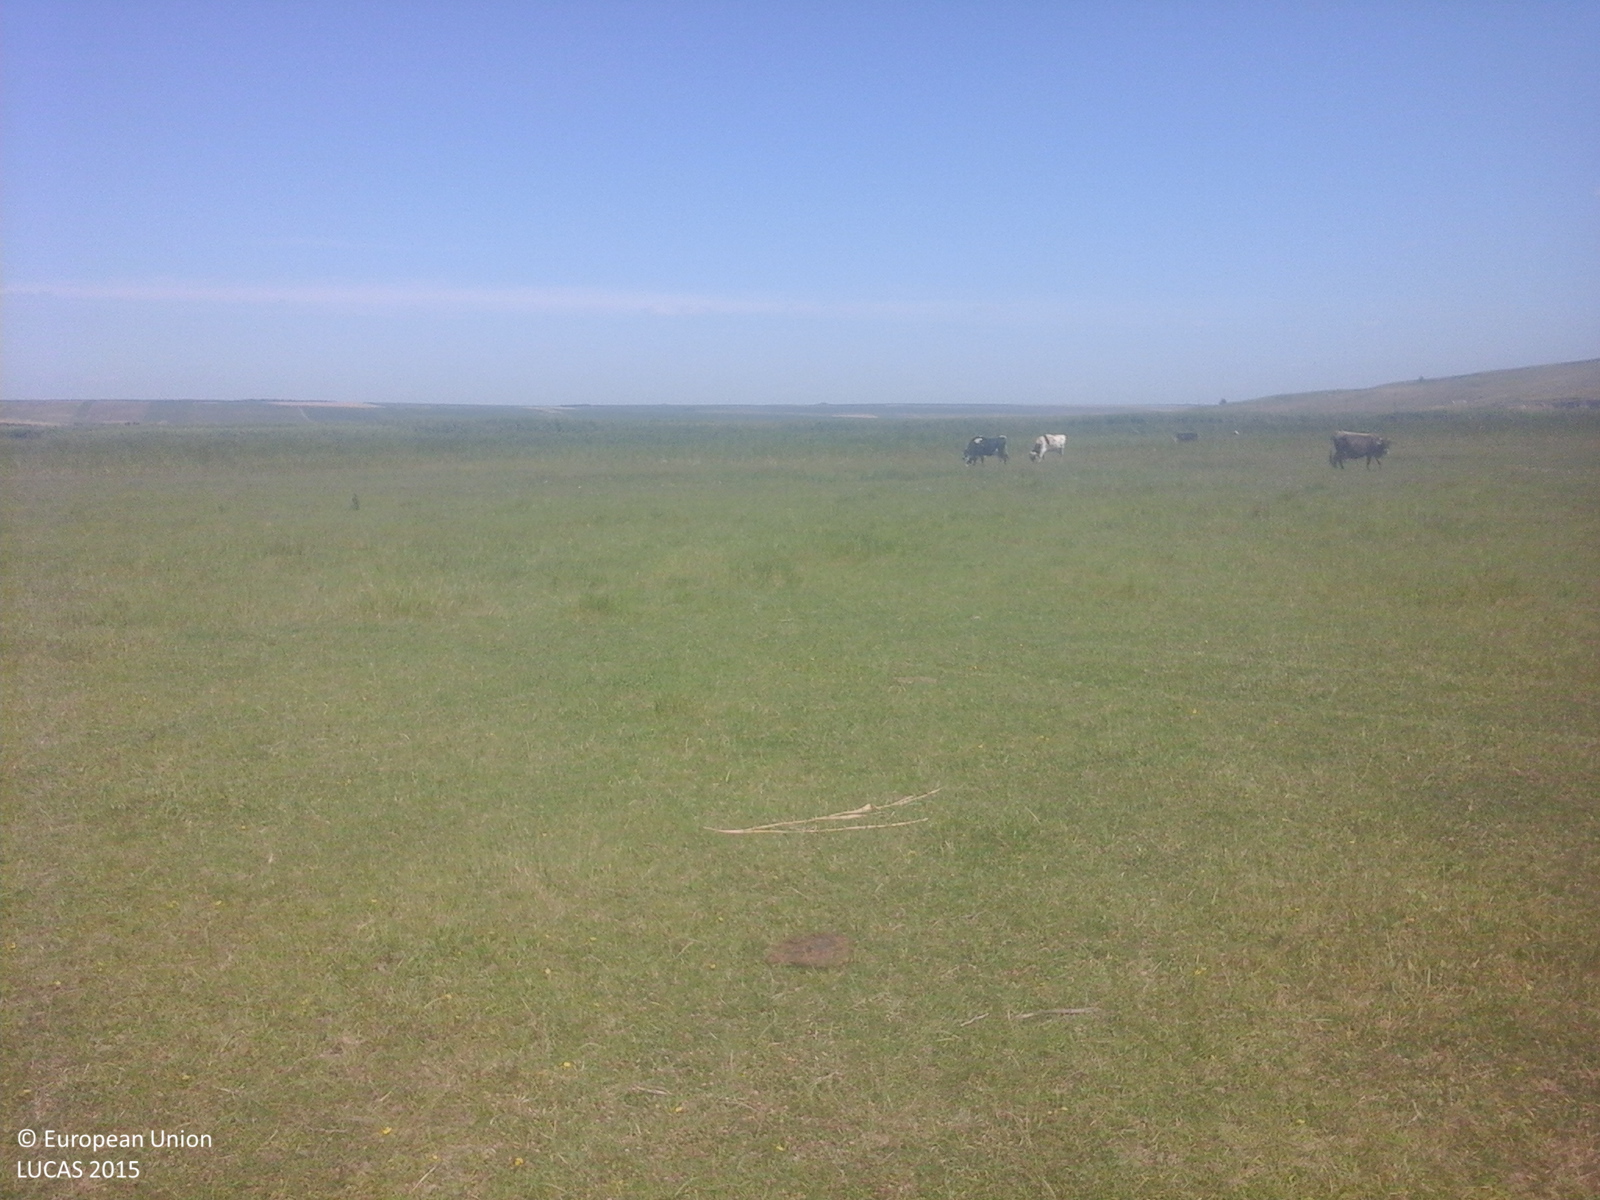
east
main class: Grassland
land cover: Grassland without tree/shrub cover
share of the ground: > 75 %
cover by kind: herbaceous plants 100 %
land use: Agriculture (excluding fallow land and kitchen gardens)
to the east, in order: Grassland without tree/shrub cover; Inland marshes
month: June
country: RO
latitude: 47.9310
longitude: 26.9286
